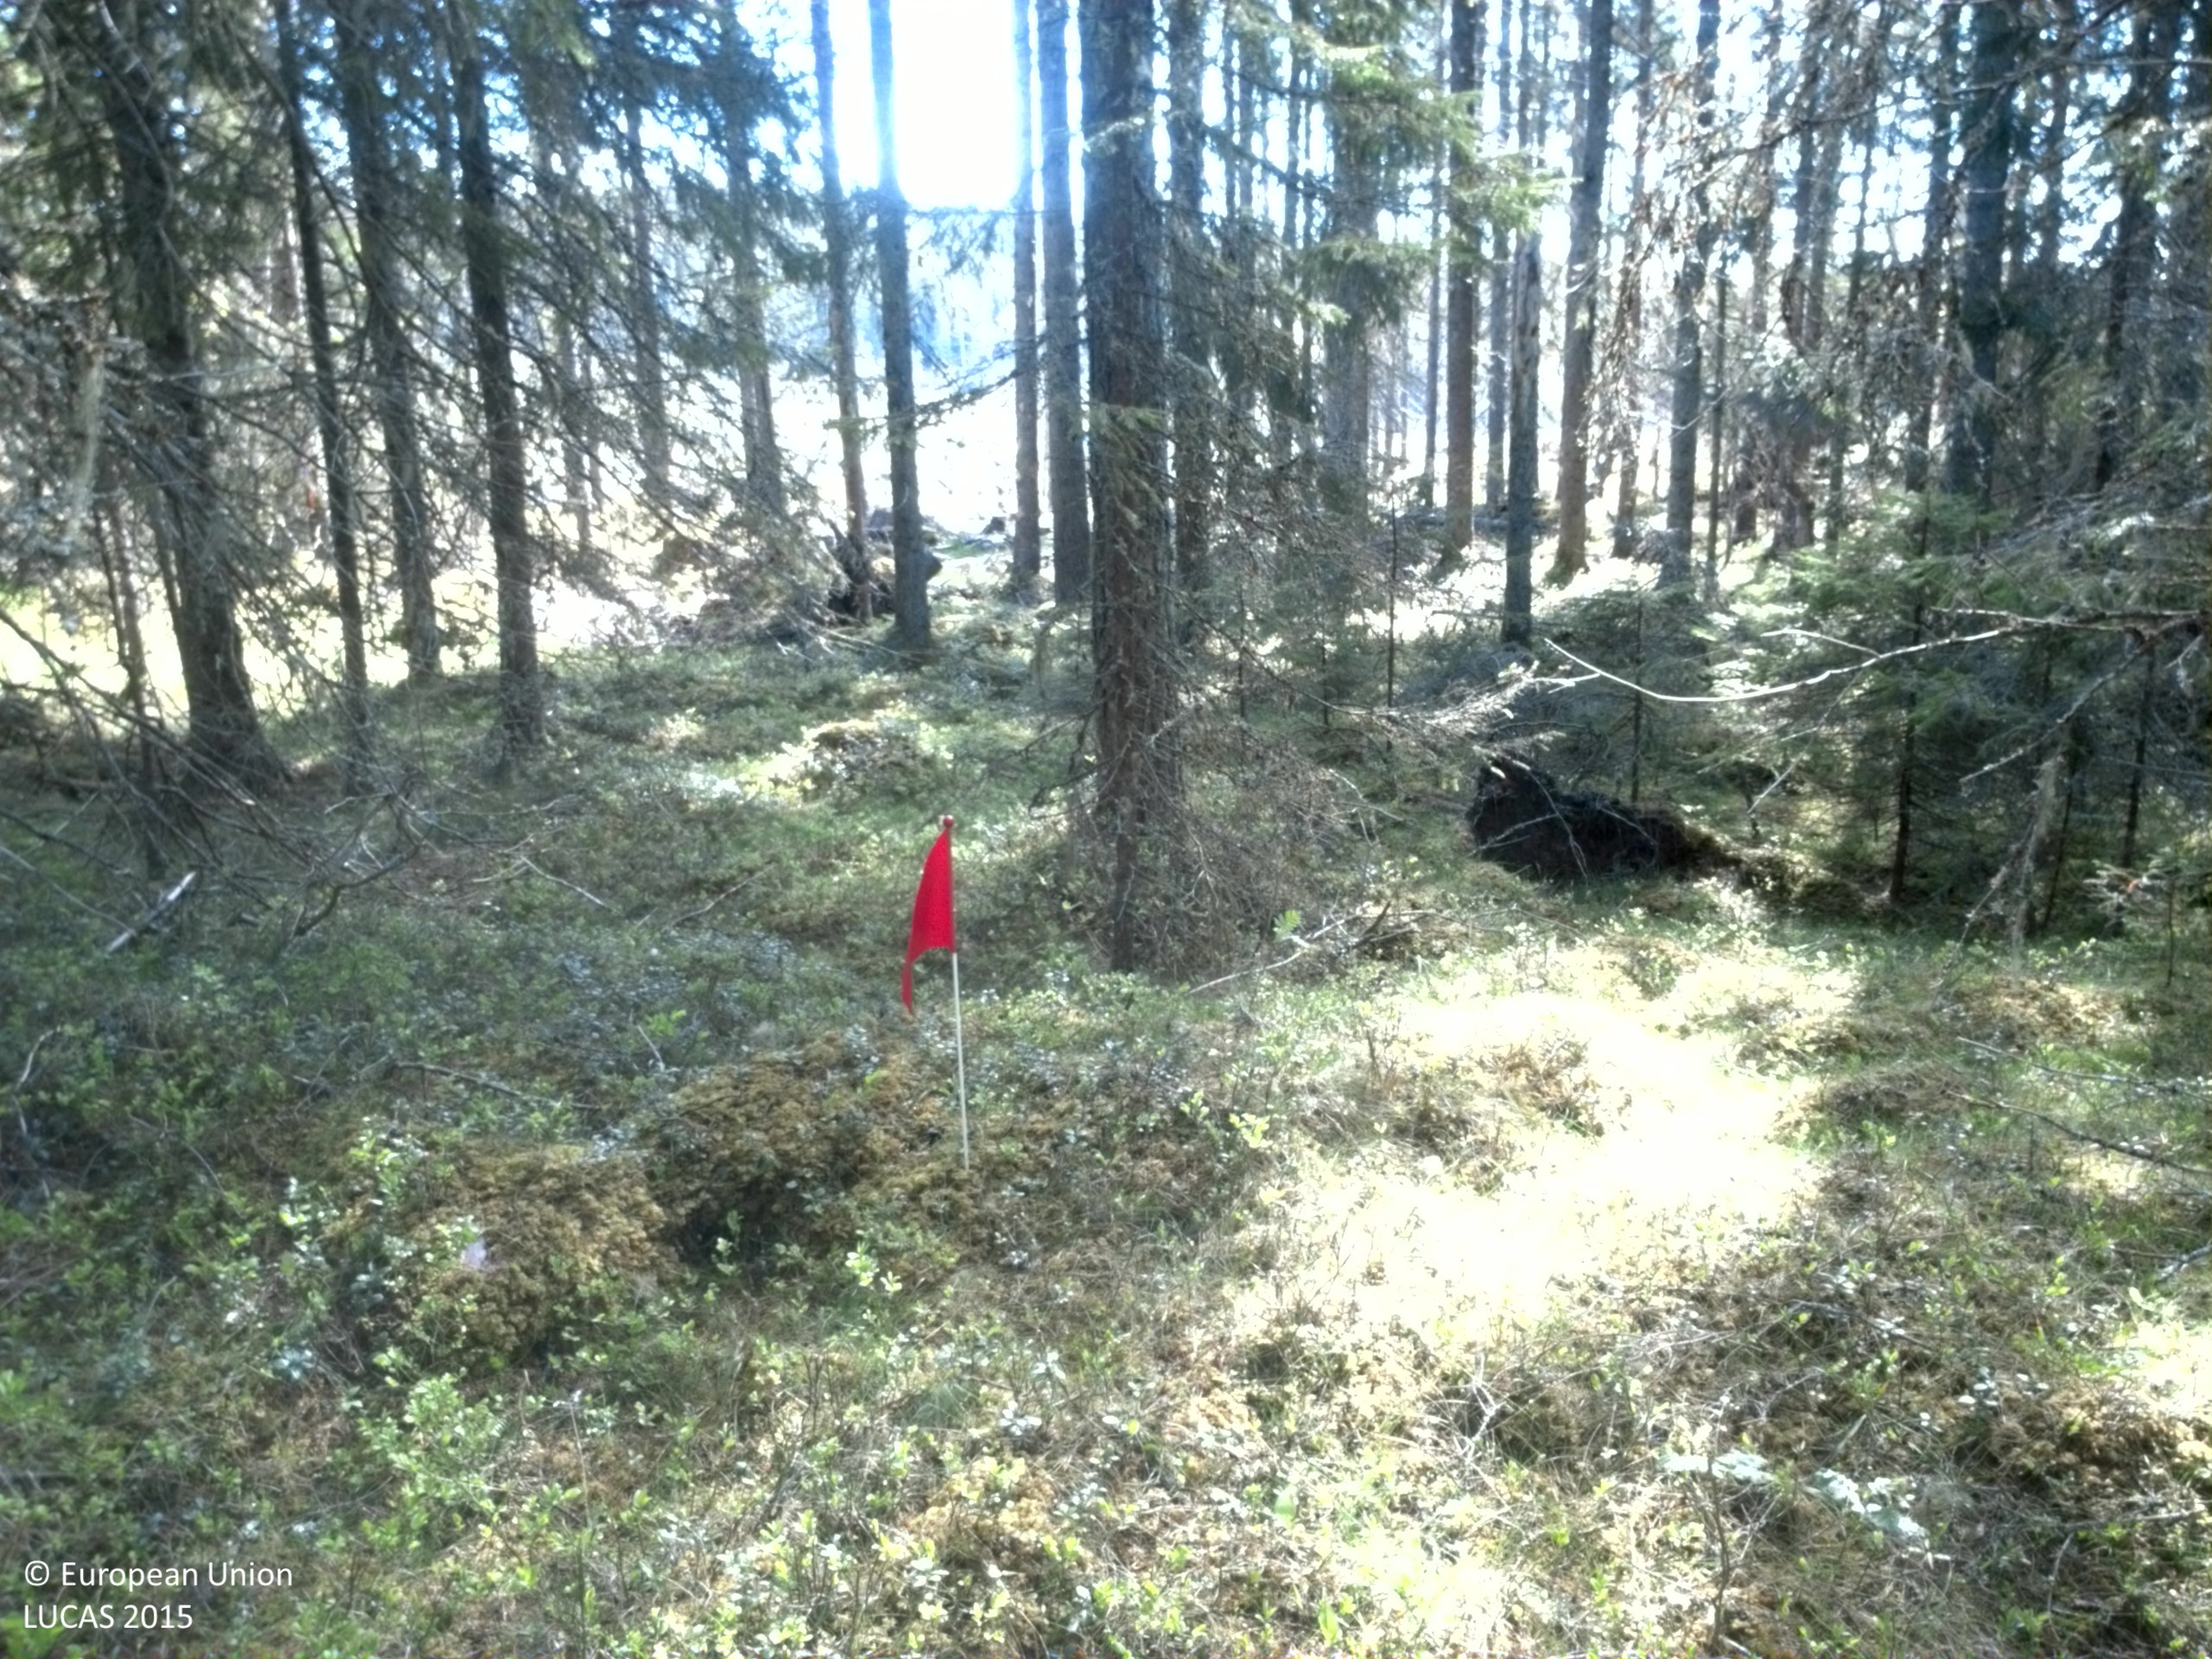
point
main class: Woodland
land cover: Spruce dominated coniferous woodland
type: boreal forest
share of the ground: > 75 %
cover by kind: coniferous forest trees 85 %, shrubs 15 %
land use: Forestry
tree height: > 5 m
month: May
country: SE
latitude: 62.8219
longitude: 18.2417
